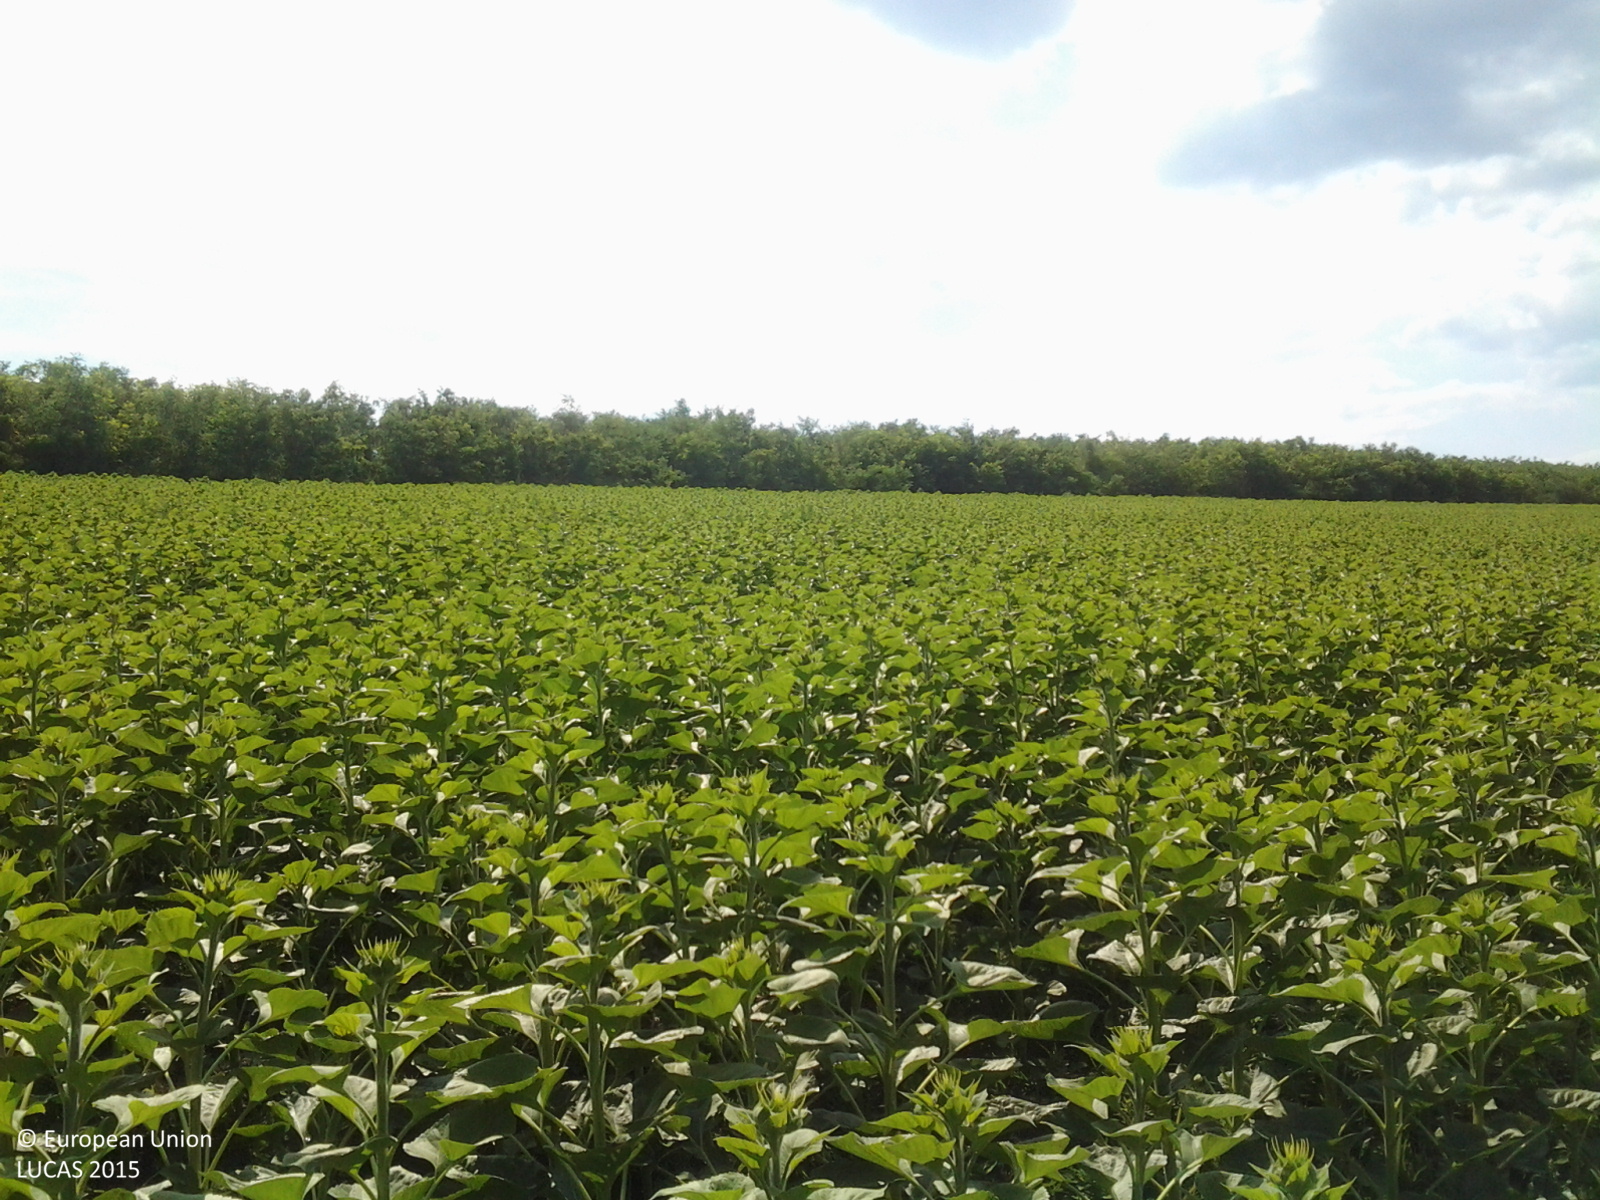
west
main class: Cropland
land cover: Sunflower
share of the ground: 50 - 75 %
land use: Agriculture (excluding fallow land and kitchen gardens)
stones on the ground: < 10 %
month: June
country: RO
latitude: 47.5233
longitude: 27.0651
